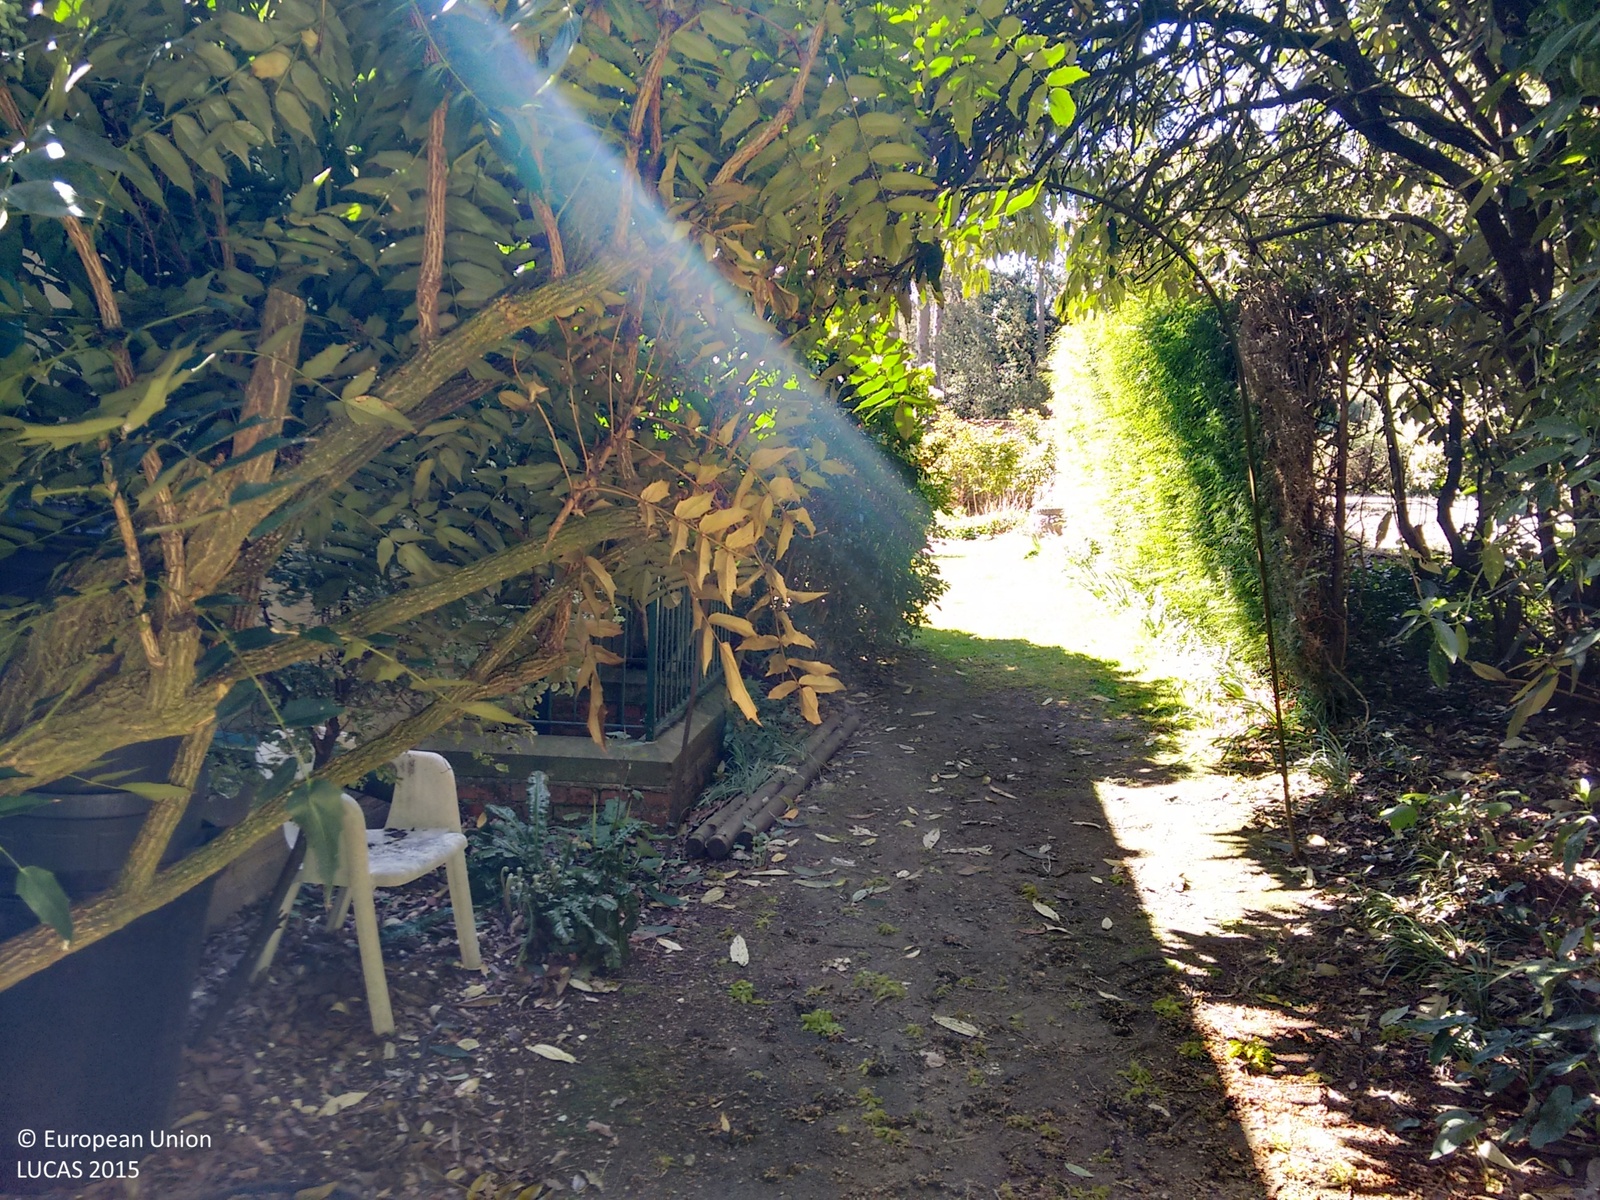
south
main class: Grassland
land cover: Grassland with sparse tree/shrub cover
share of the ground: > 75 %
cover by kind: herbaceous plants 95 %, broadleaved forest trees 5 %
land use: Residential
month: April
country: GB
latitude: 51.1470
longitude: -1.4725
